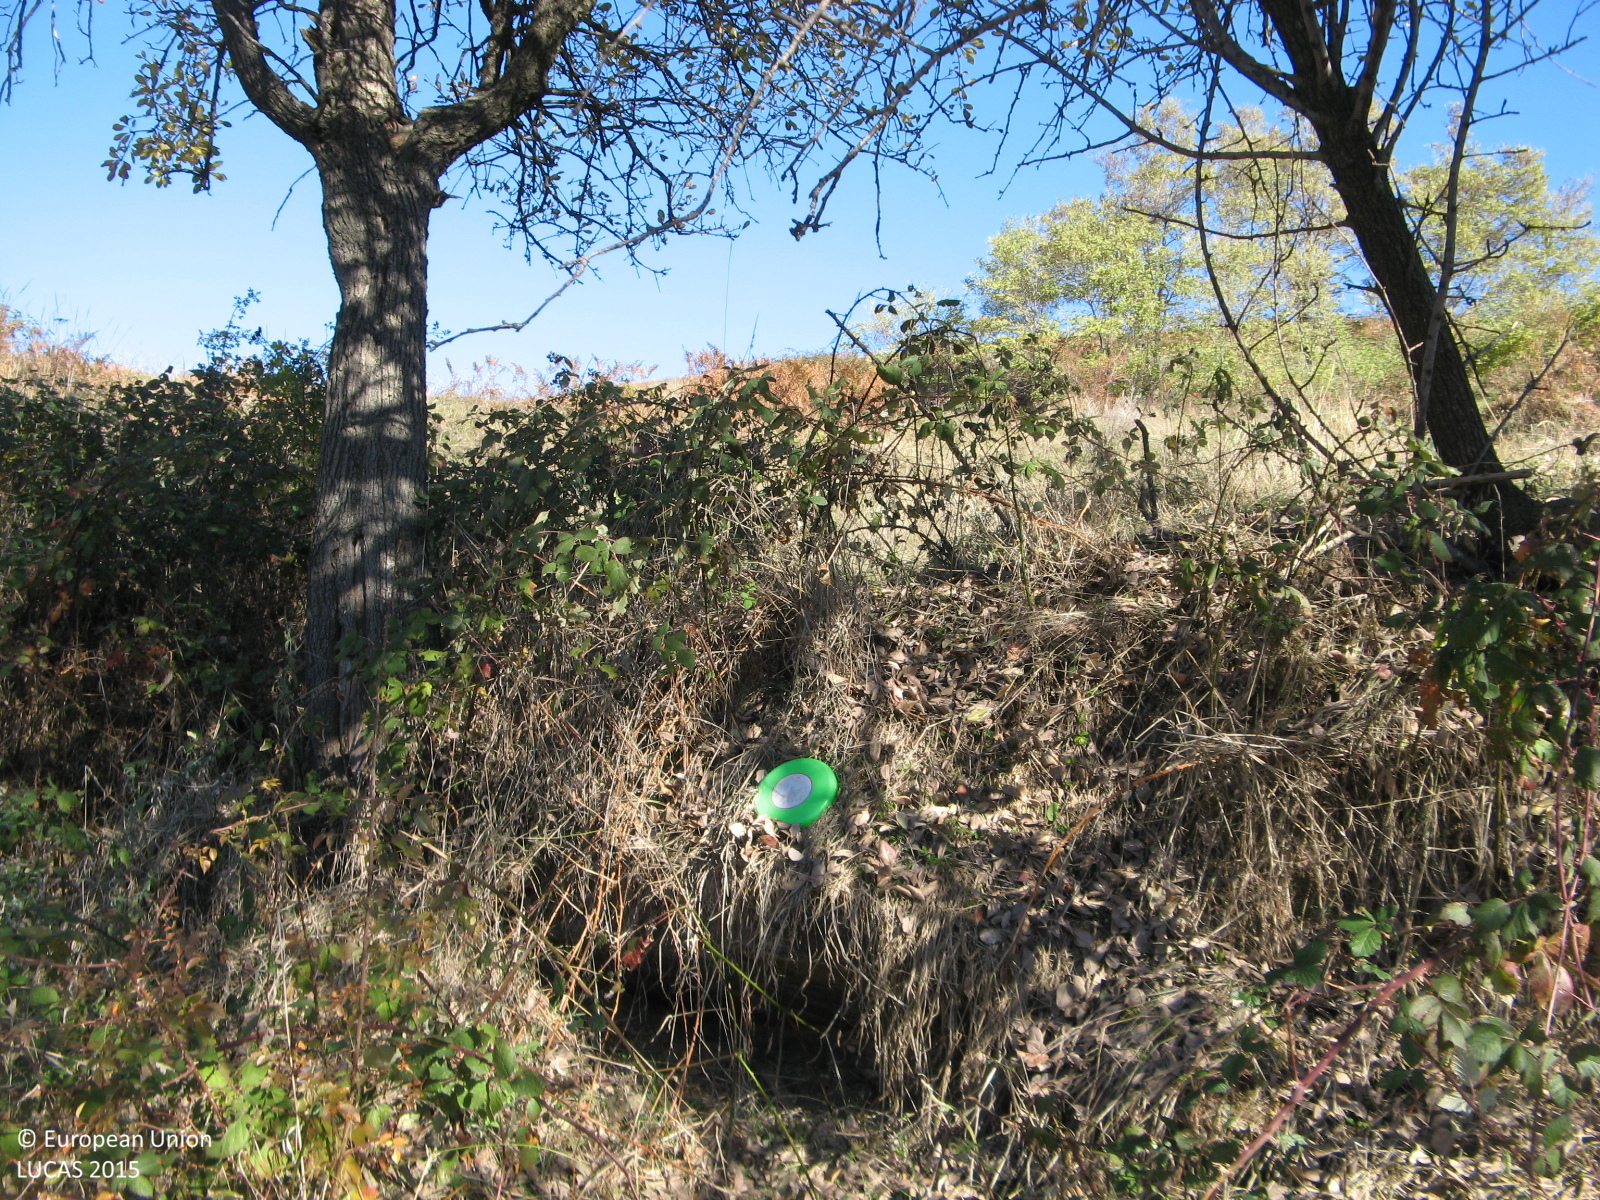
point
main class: Grassland
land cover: Grassland with sparse tree/shrub cover
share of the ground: > 75 %
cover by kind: herbaceous plants 85 %, shrubs 10 %, broadleaved forest trees 5 %
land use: Agriculture (excluding fallow land and kitchen gardens)
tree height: > 5 m
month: November
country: BG
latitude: 41.6504
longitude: 25.1703
